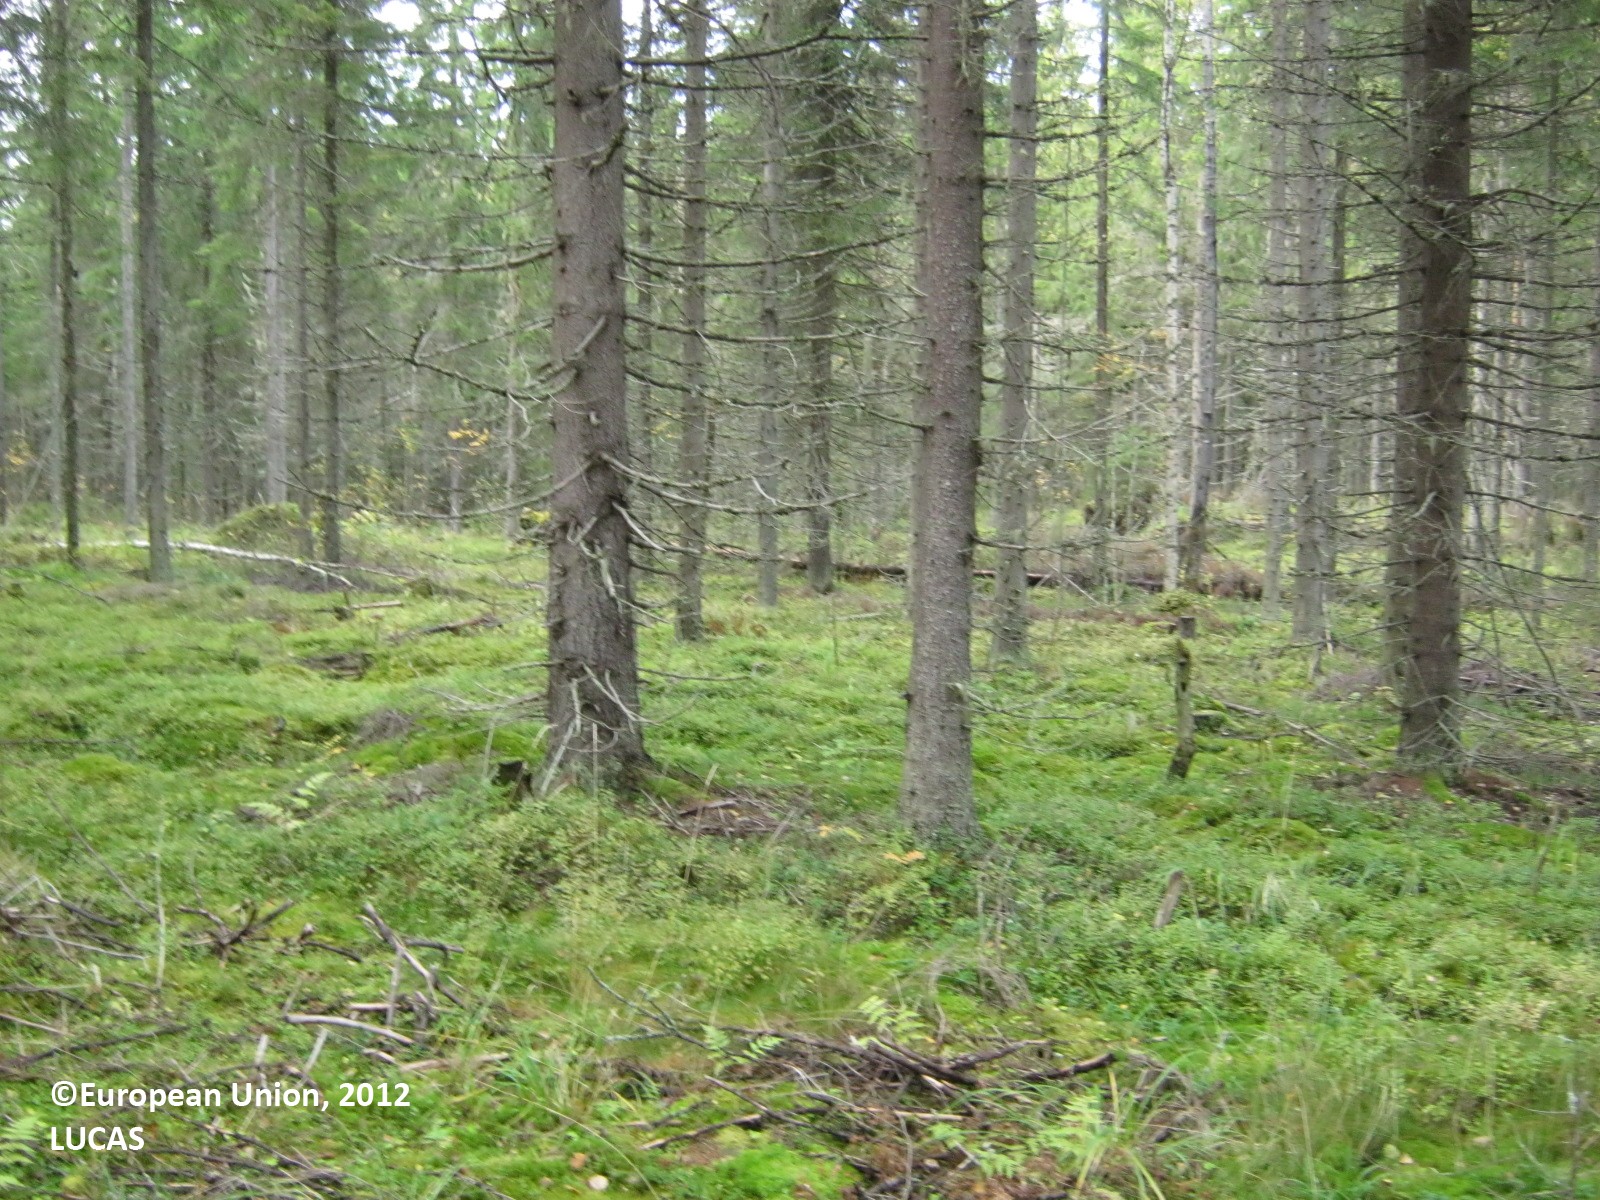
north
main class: Woodland
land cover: Spruce dominated coniferous woodland
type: boreal forest
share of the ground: 50 - 75 %
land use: Forestry
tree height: > 5 m
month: September
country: FI
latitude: 62.4050
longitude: 28.8905
